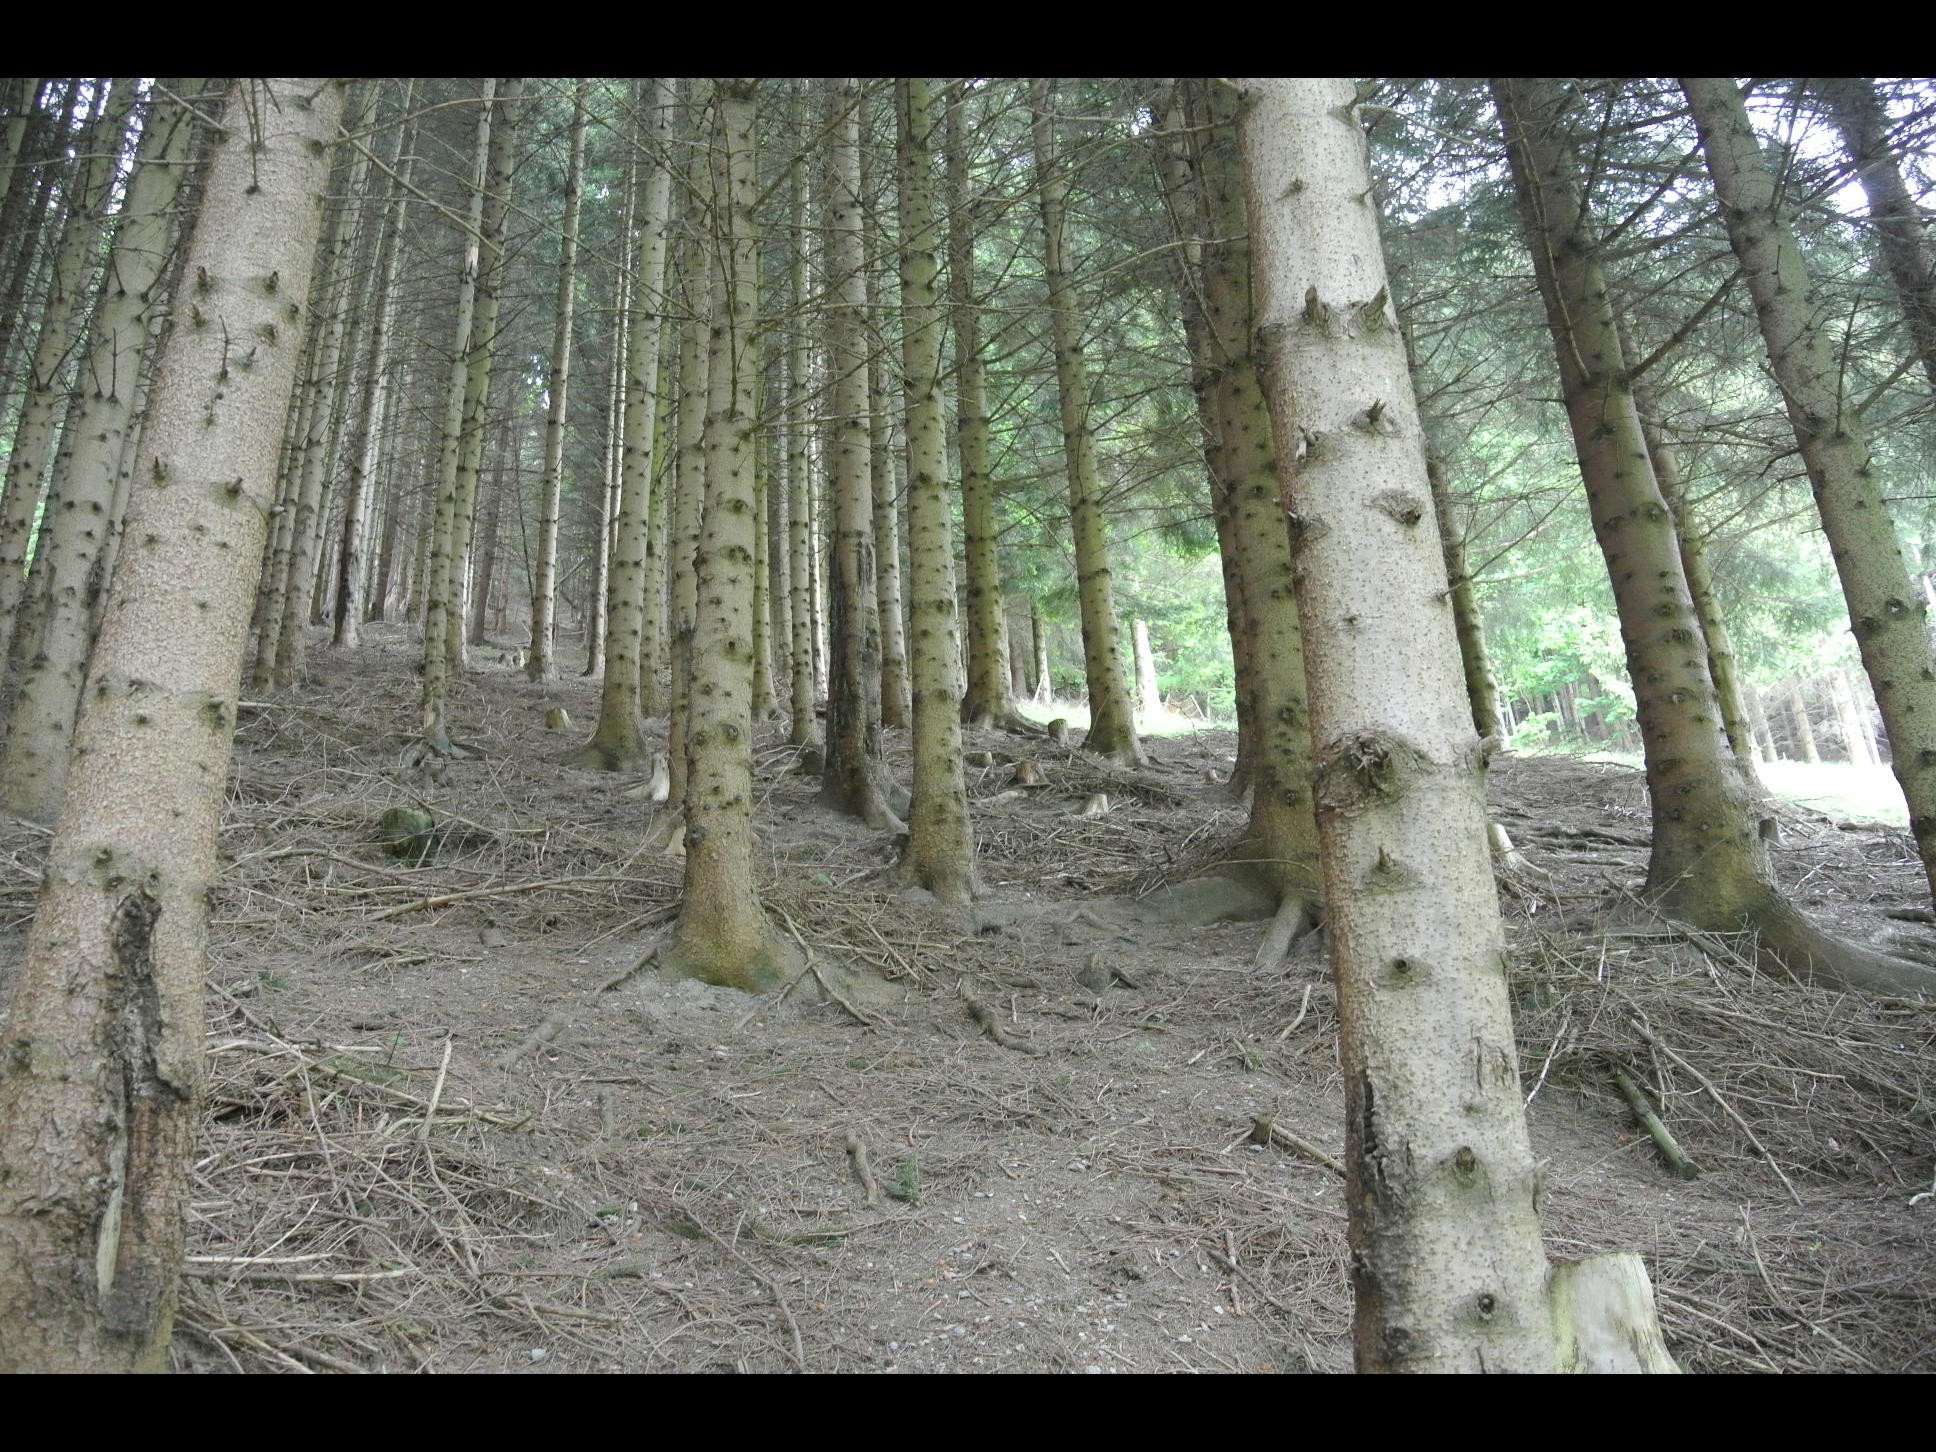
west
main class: Woodland
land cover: Spruce dominated coniferous woodland
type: alpine coniferous forest
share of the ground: > 75 %
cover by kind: coniferous forest trees 100 %
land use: Forestry
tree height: > 5 m
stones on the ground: 10 - 25 %
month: May
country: AT
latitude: 47.6770
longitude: 15.7428
